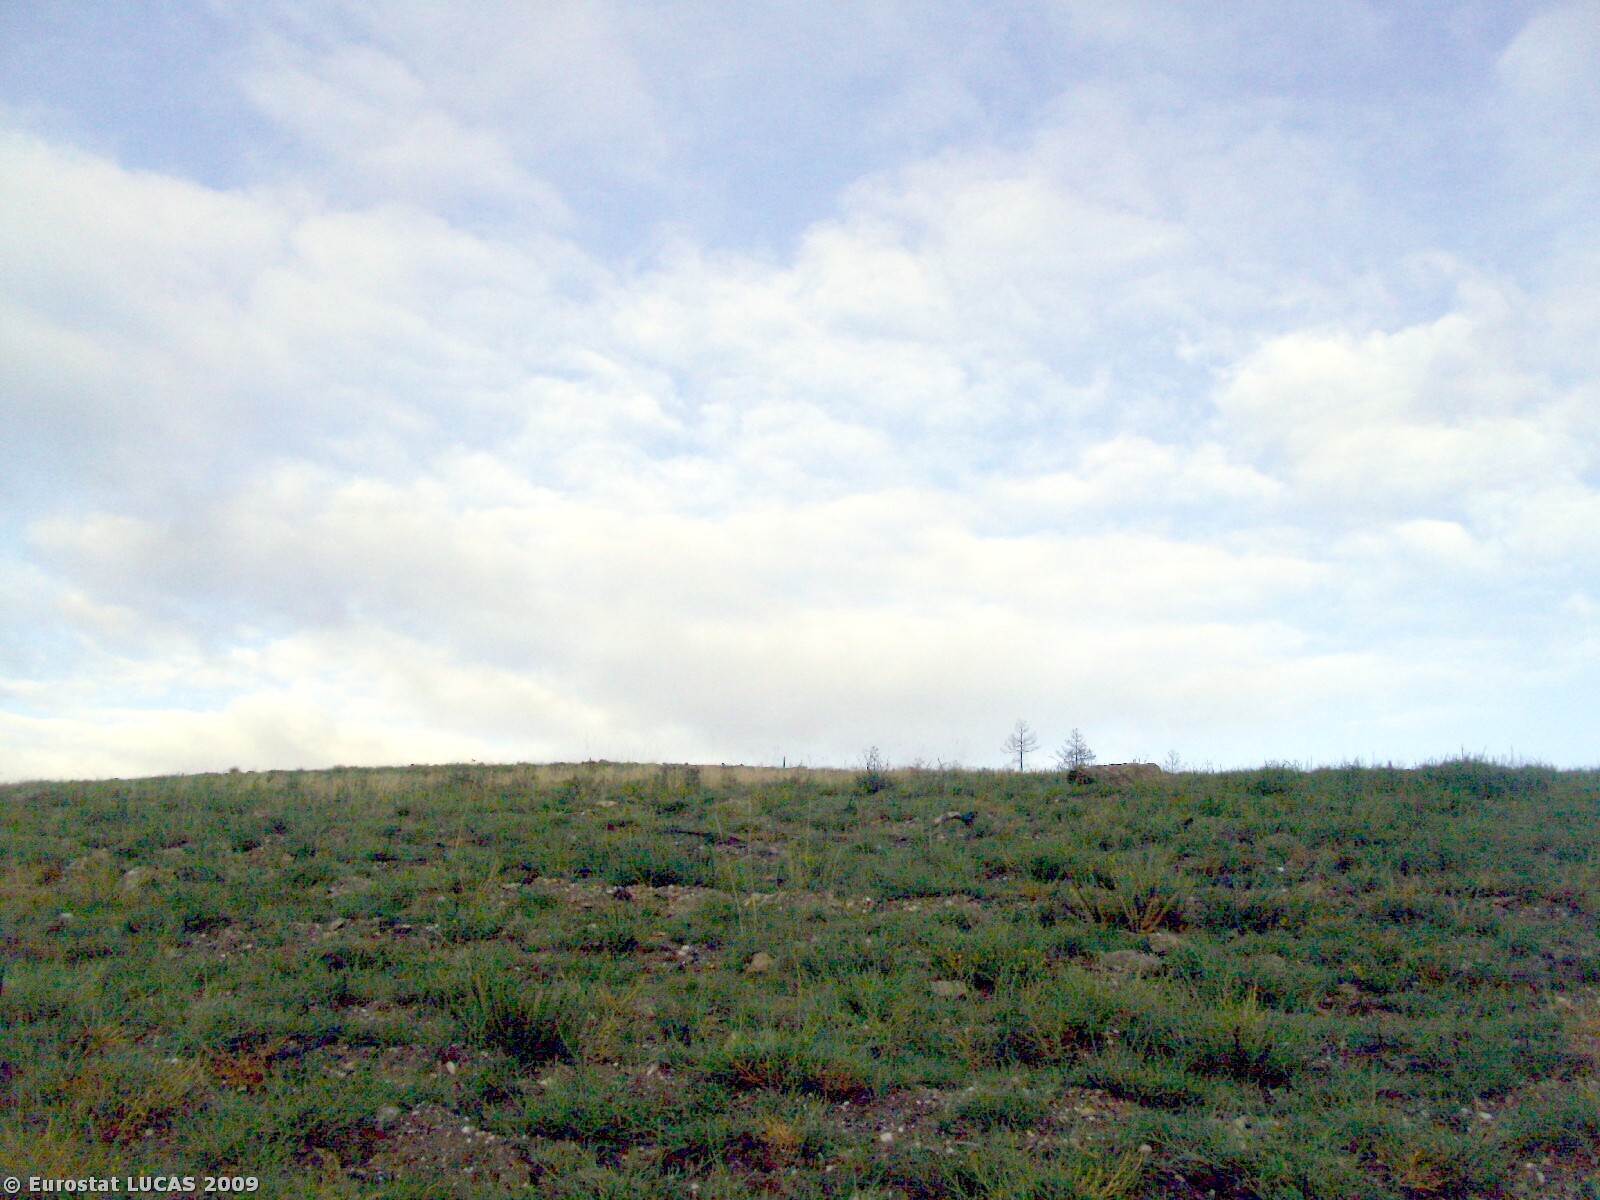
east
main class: Shrubland
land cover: Shrubland without tree cover
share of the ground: > 75 %
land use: Unused
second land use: Energy production
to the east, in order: Shrubland without tree cover; Coniferous woodland
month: September
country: PT
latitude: 41.6838
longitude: -7.9339
